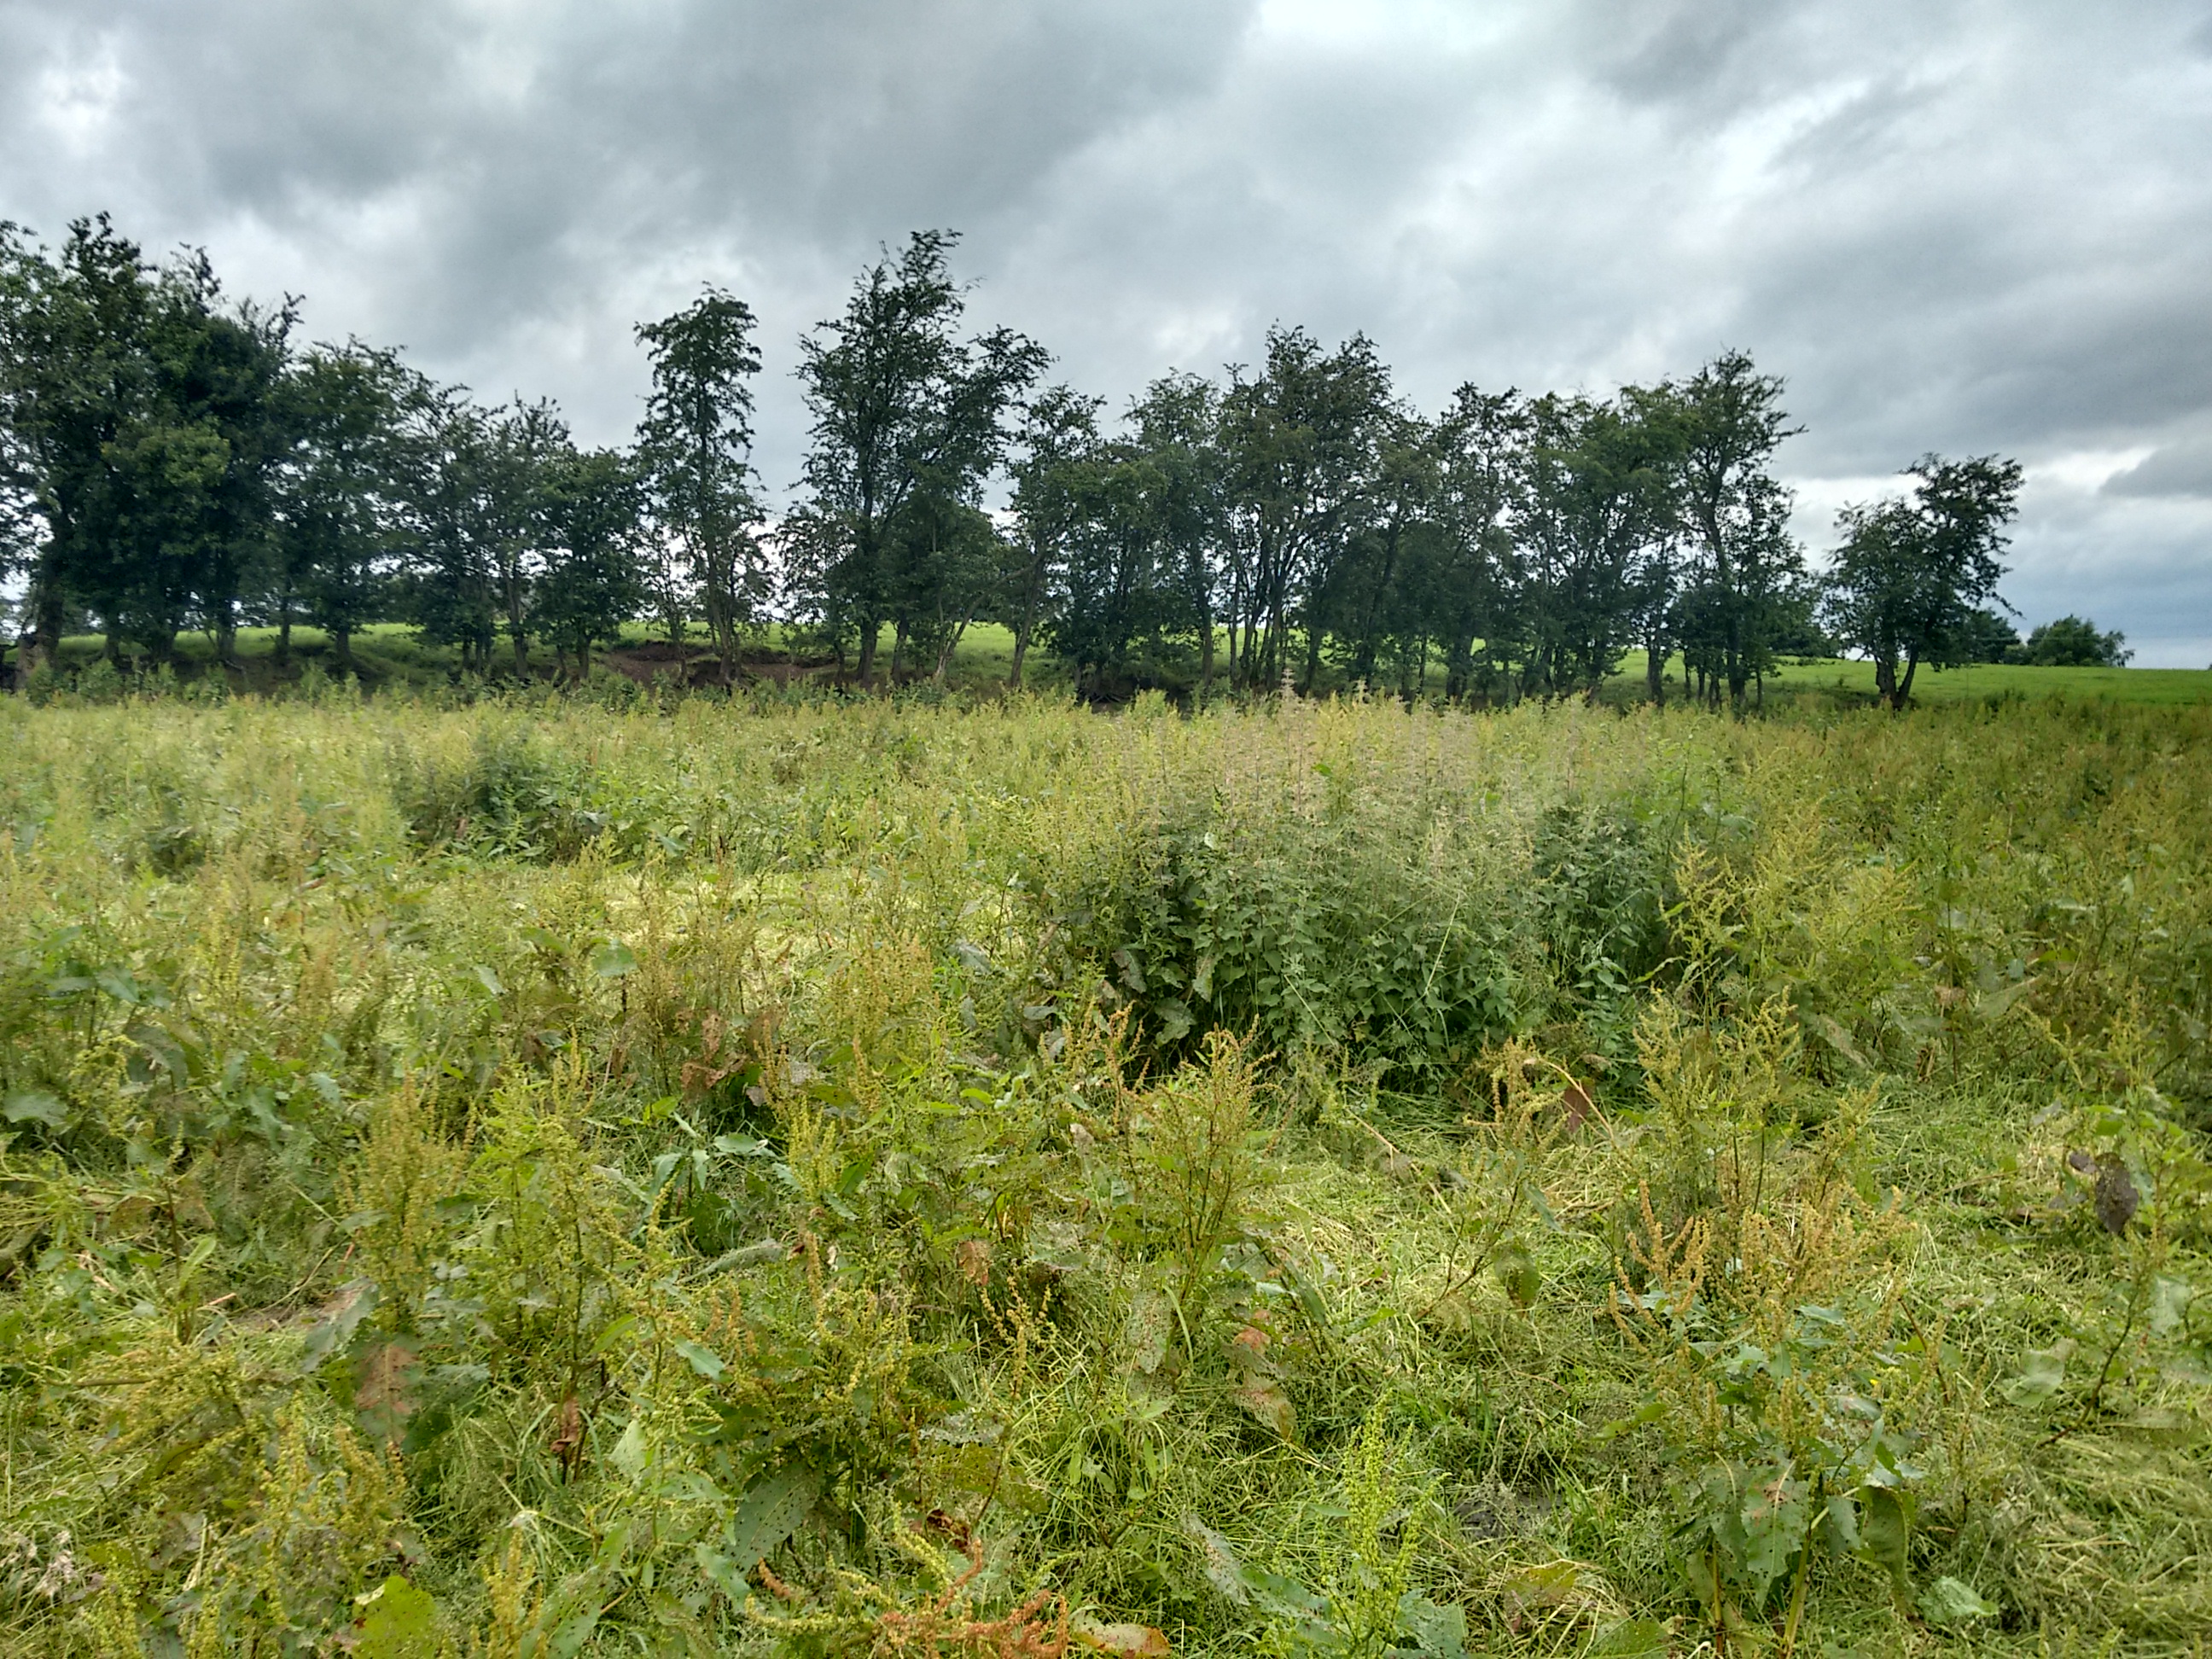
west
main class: Grassland
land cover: Grassland without tree/shrub cover
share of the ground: > 75 %
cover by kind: herbaceous plants 100 %
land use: Agriculture (excluding fallow land and kitchen gardens)
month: July
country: GB
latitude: 54.5736
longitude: -7.1766
